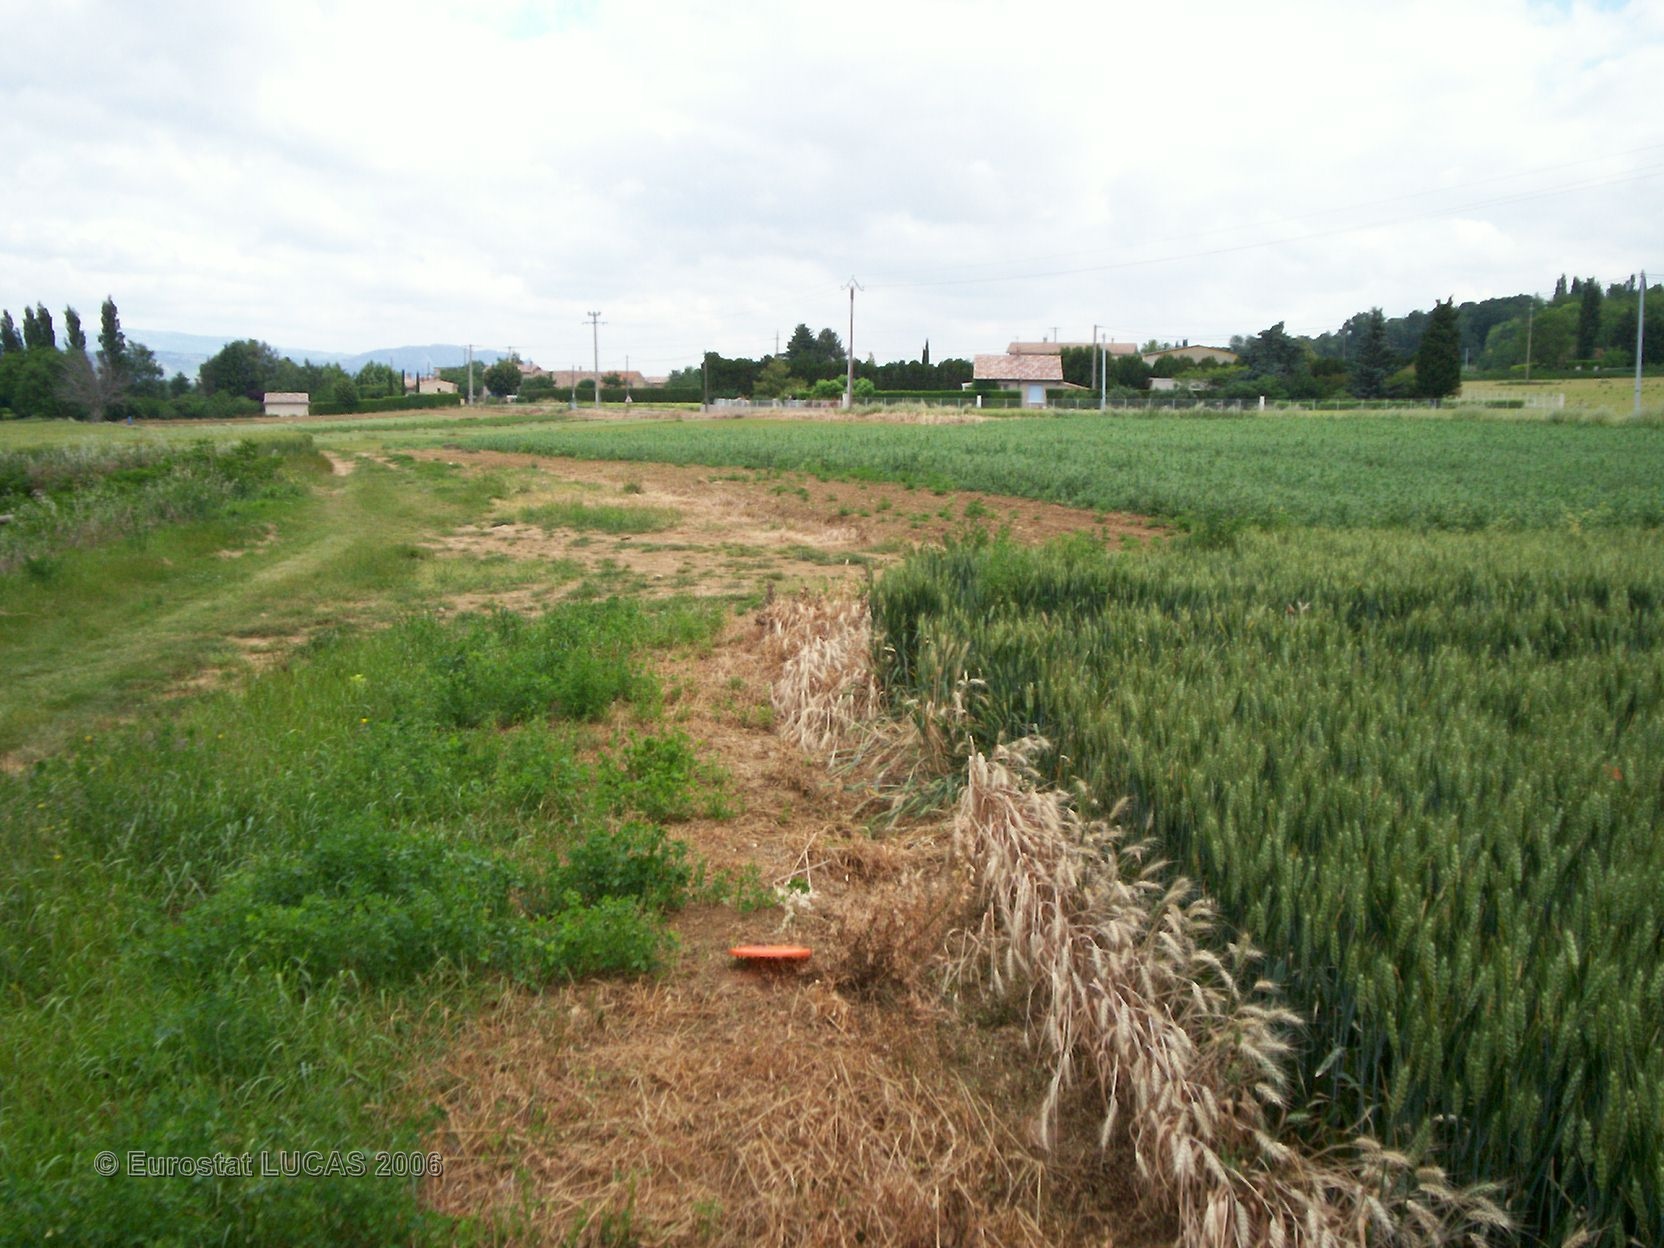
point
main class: Grassland
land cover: Grassland without tree/shrub cover
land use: Agriculture (excluding fallow land and kitchen gardens)
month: June
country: FR
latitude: 44.8206
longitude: 4.8842
